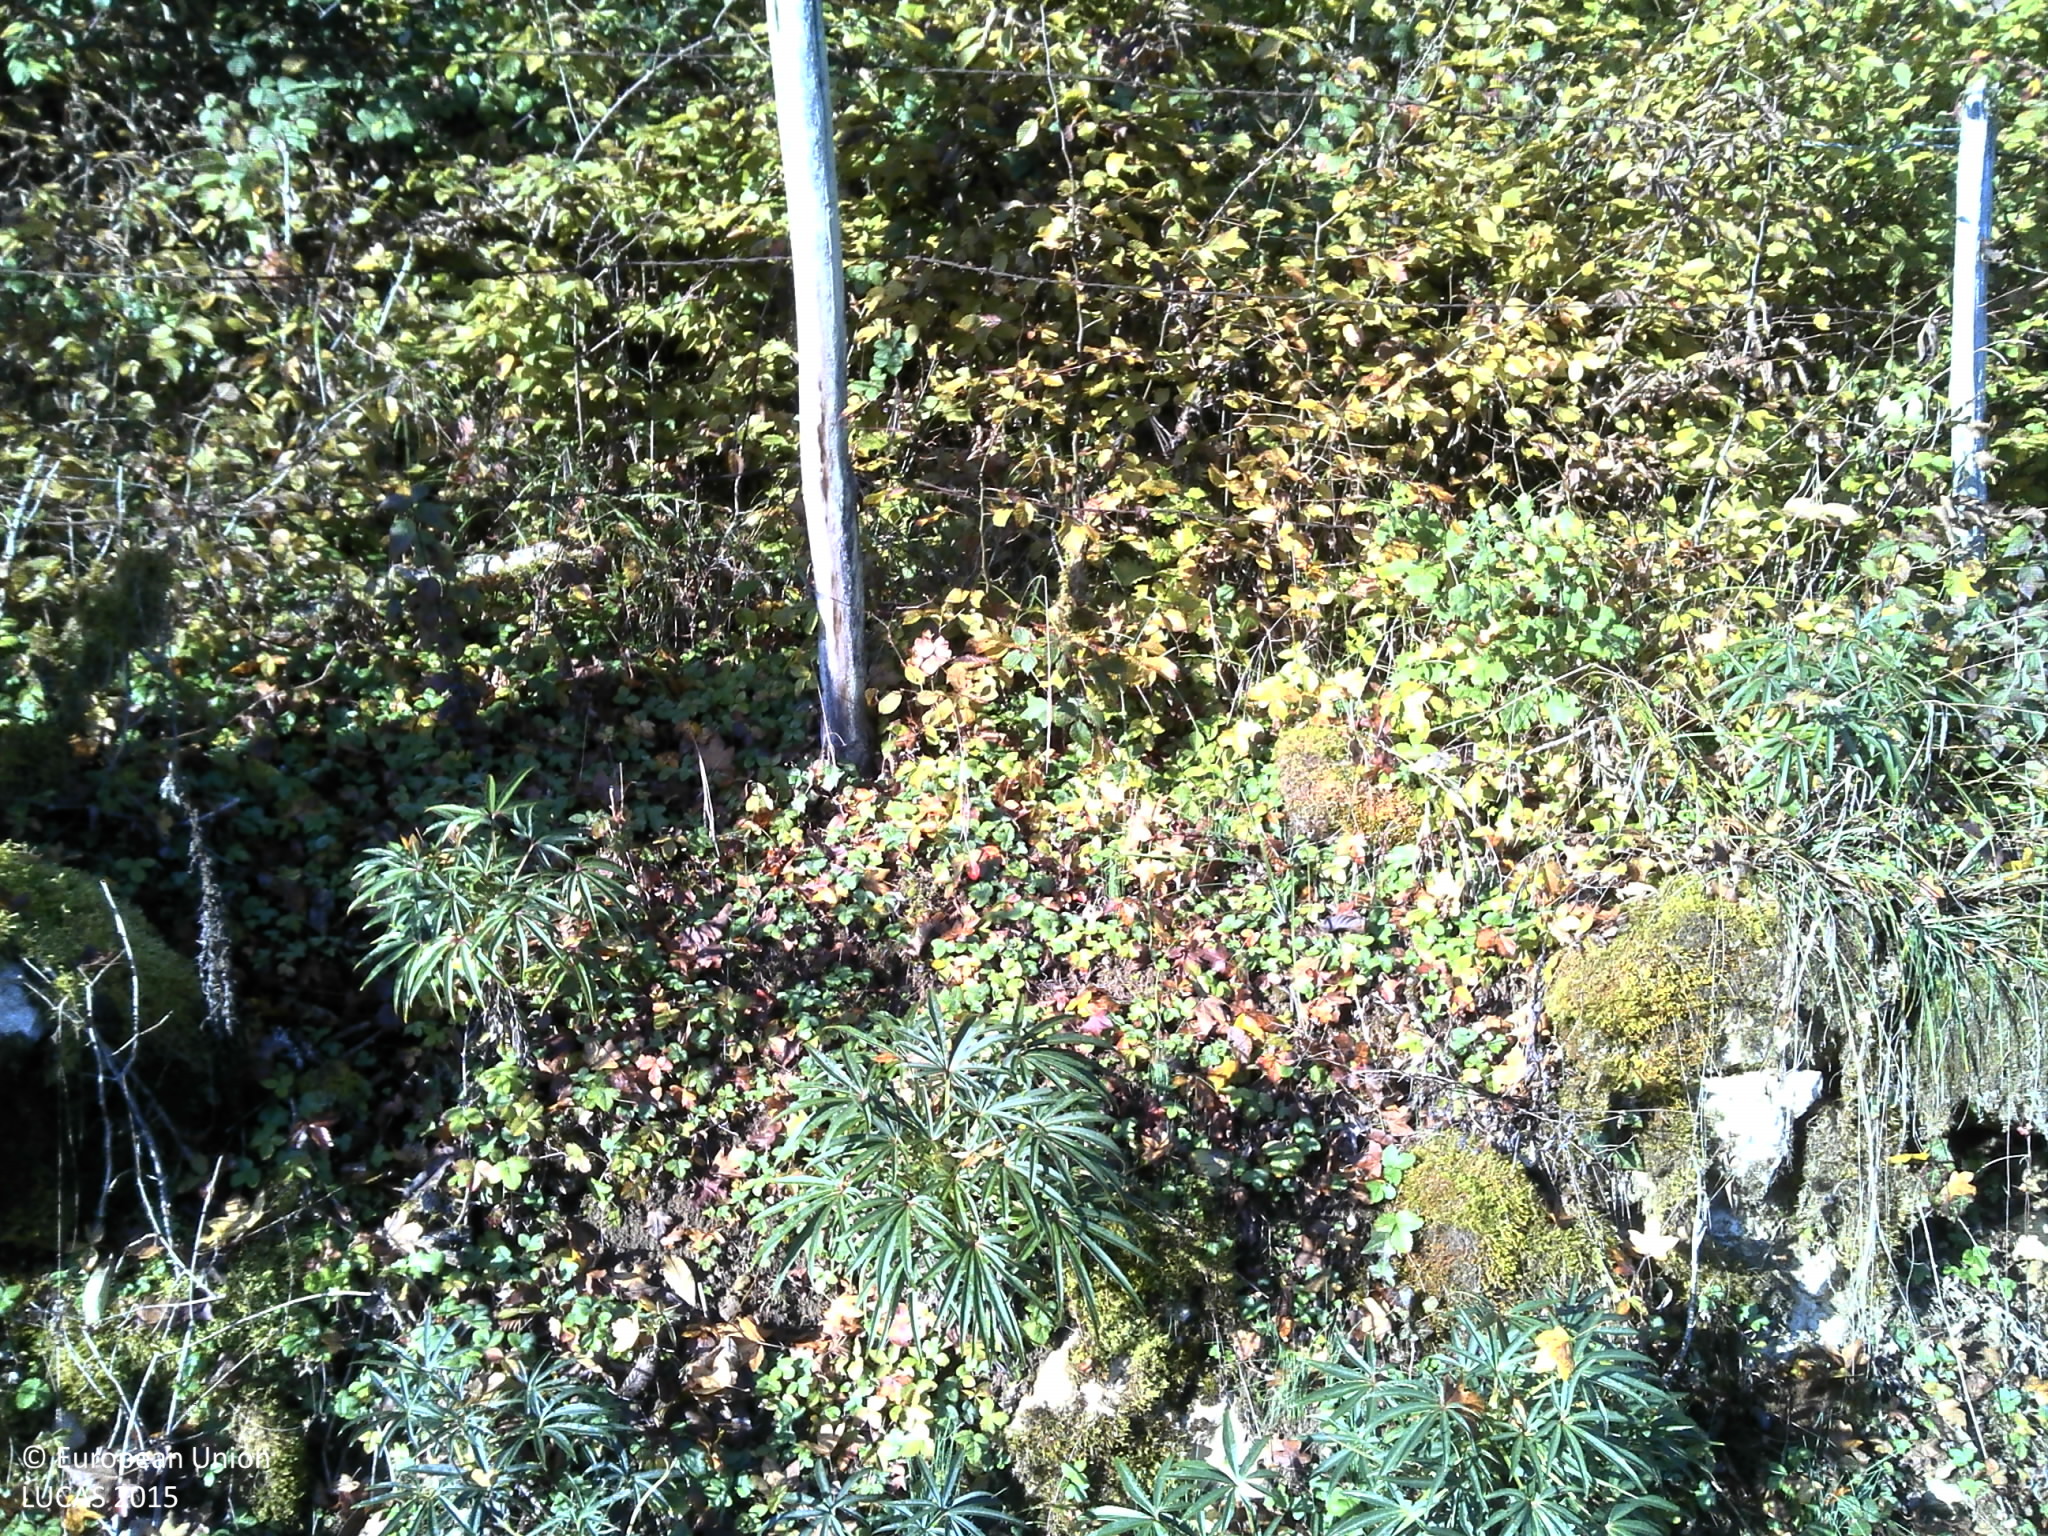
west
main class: Shrubland
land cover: Shrubland with sparse tree cover
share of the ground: > 75 %
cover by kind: shrubs 95 %, broadleaved forest trees 5 %
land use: Semi-natural and natural areas not in use
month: October
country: FR
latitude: 45.9286
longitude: 5.4257
